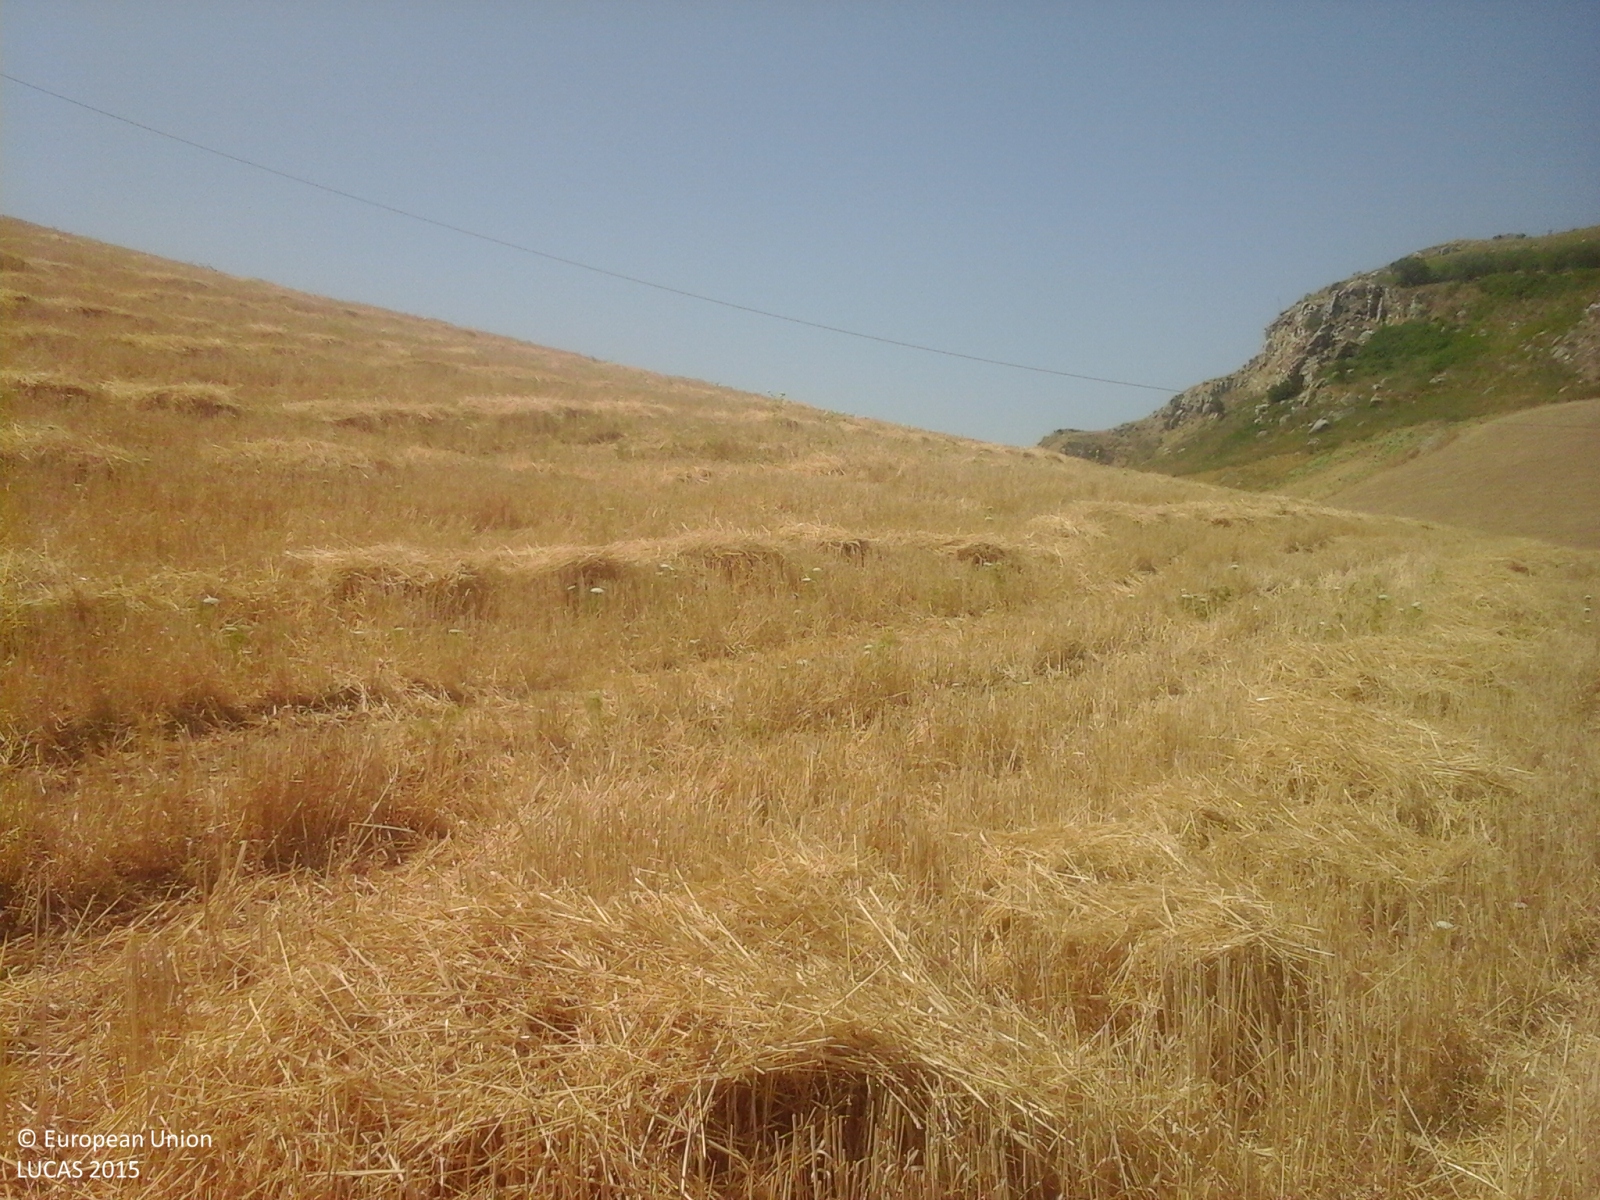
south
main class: Cropland
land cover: Durum wheat
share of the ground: > 75 %
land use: Agriculture (excluding fallow land and kitchen gardens)
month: July
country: IT
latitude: 37.4646
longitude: 13.5120
